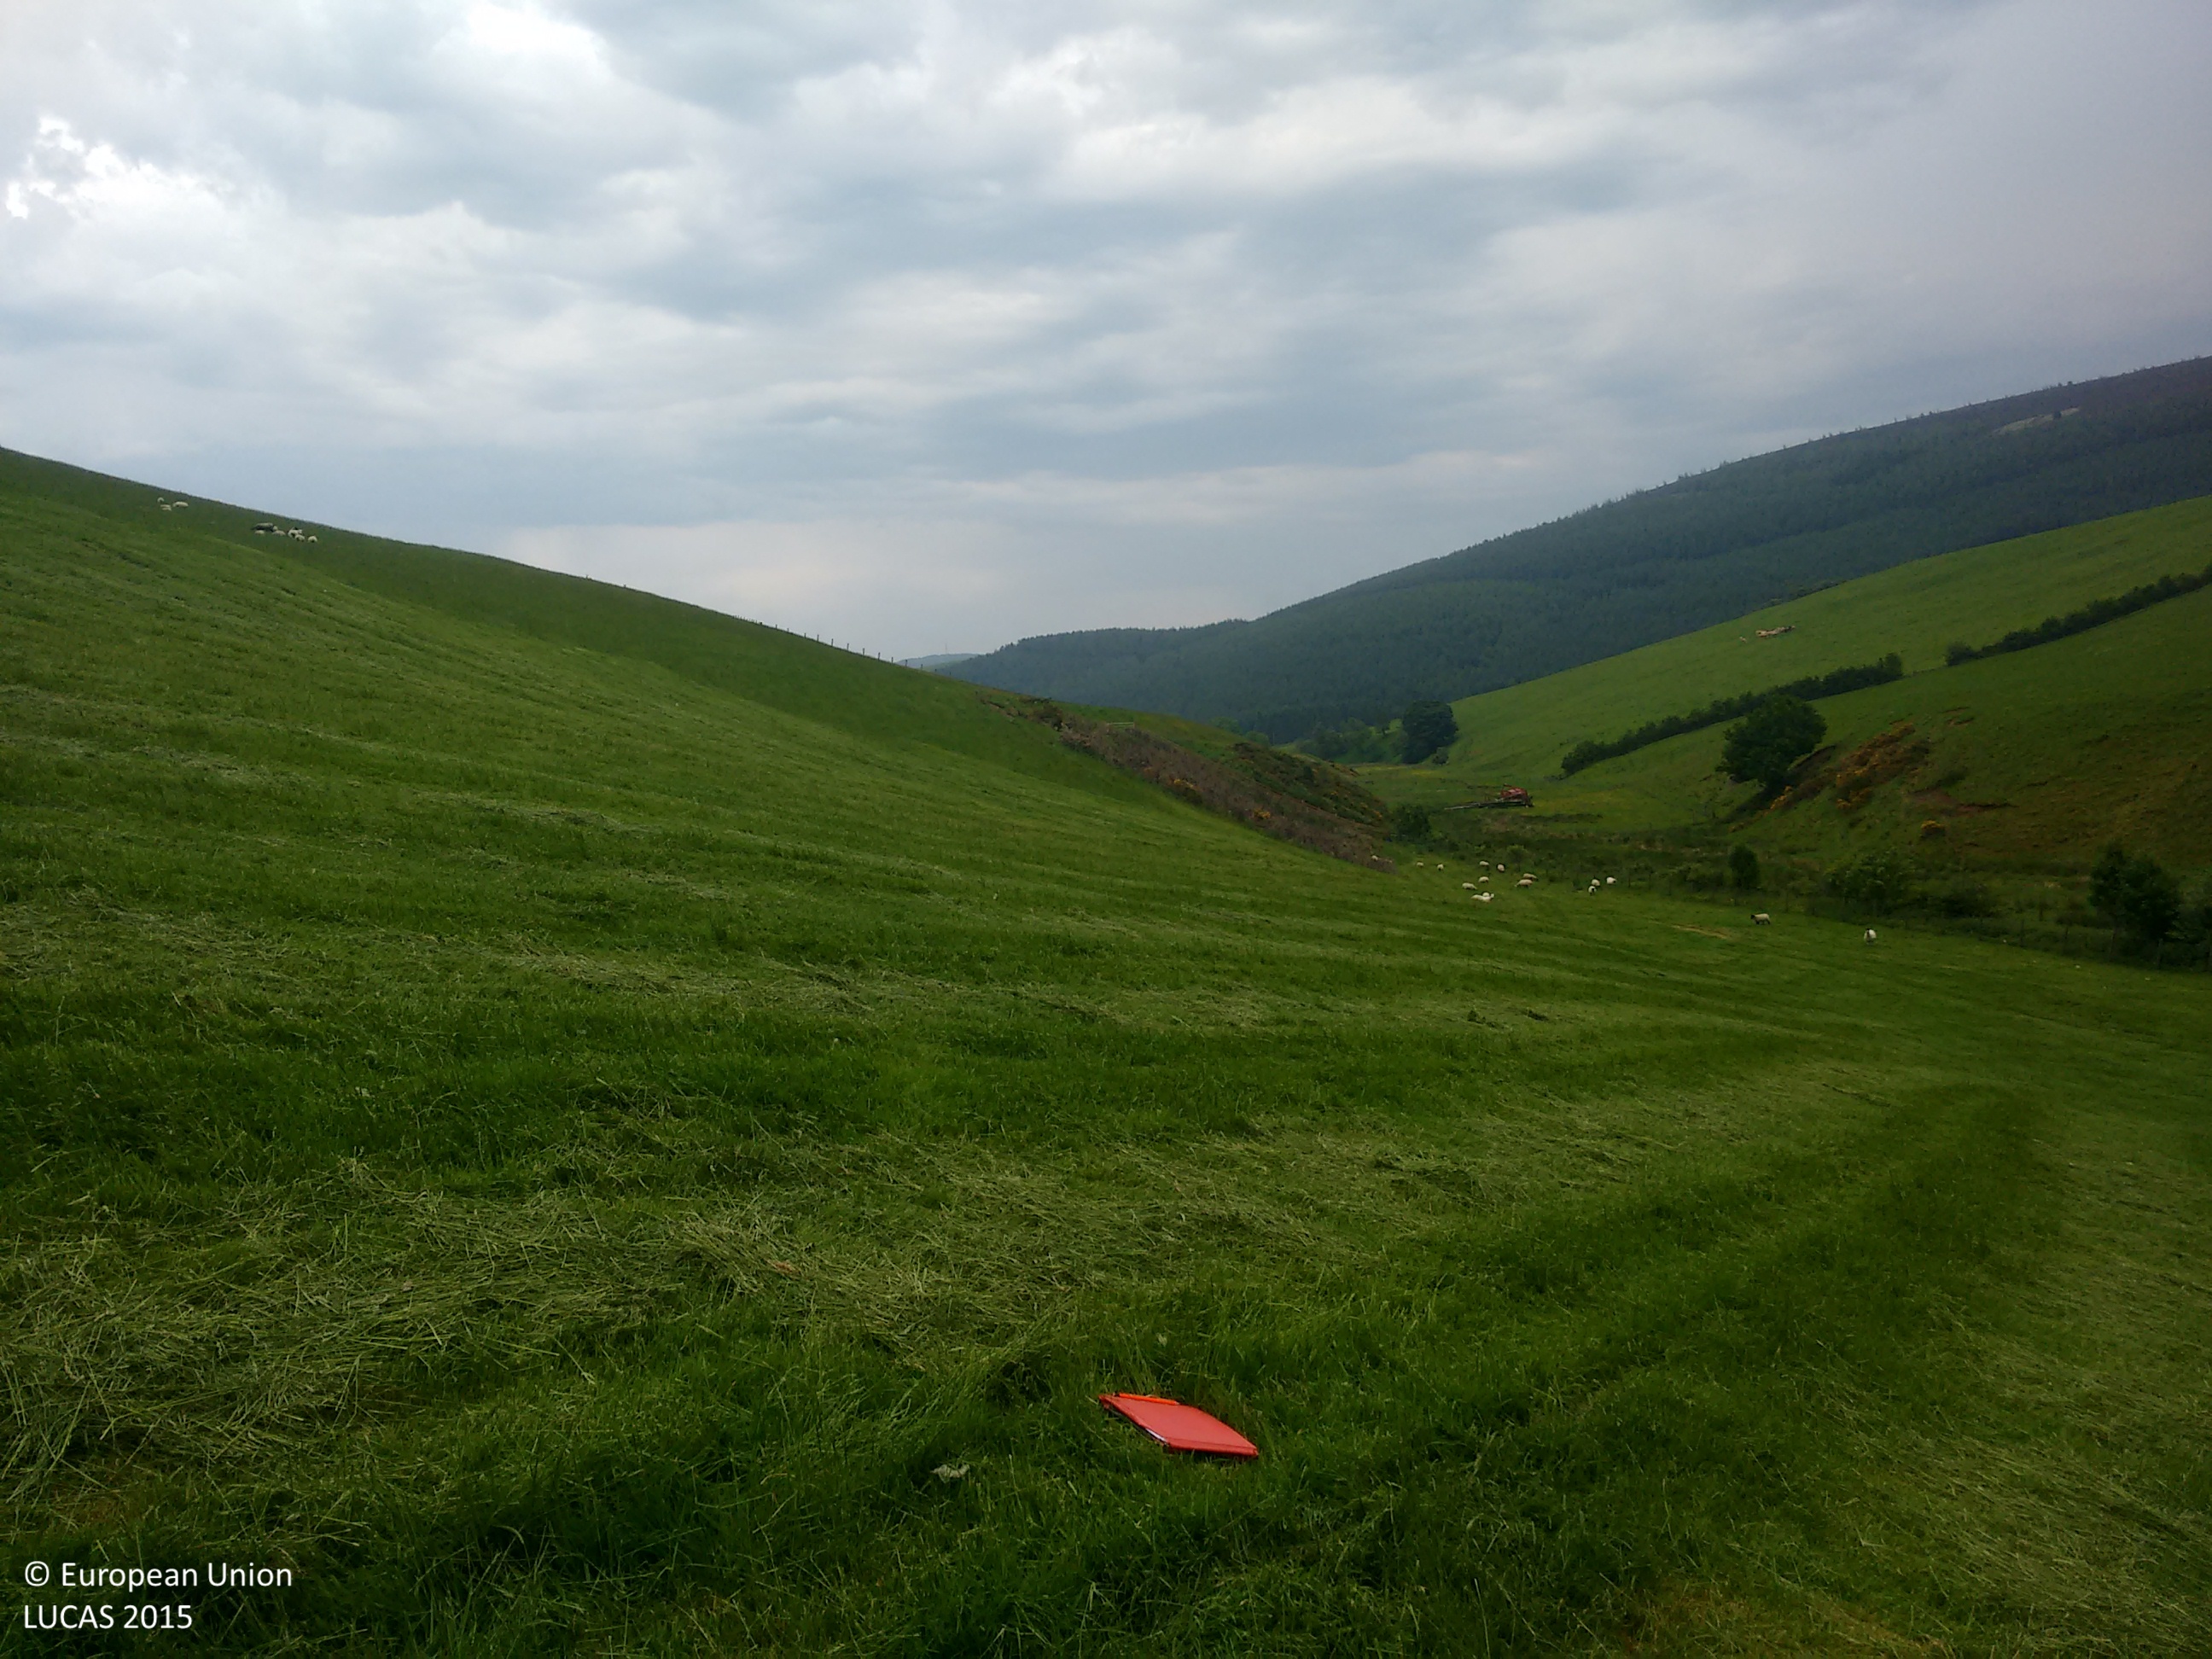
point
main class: Grassland
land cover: Grassland without tree/shrub cover
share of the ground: > 75 %
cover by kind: herbaceous plants 100 %
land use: Agriculture (excluding fallow land and kitchen gardens)
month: July
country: GB
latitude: 57.3804
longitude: -2.8498
